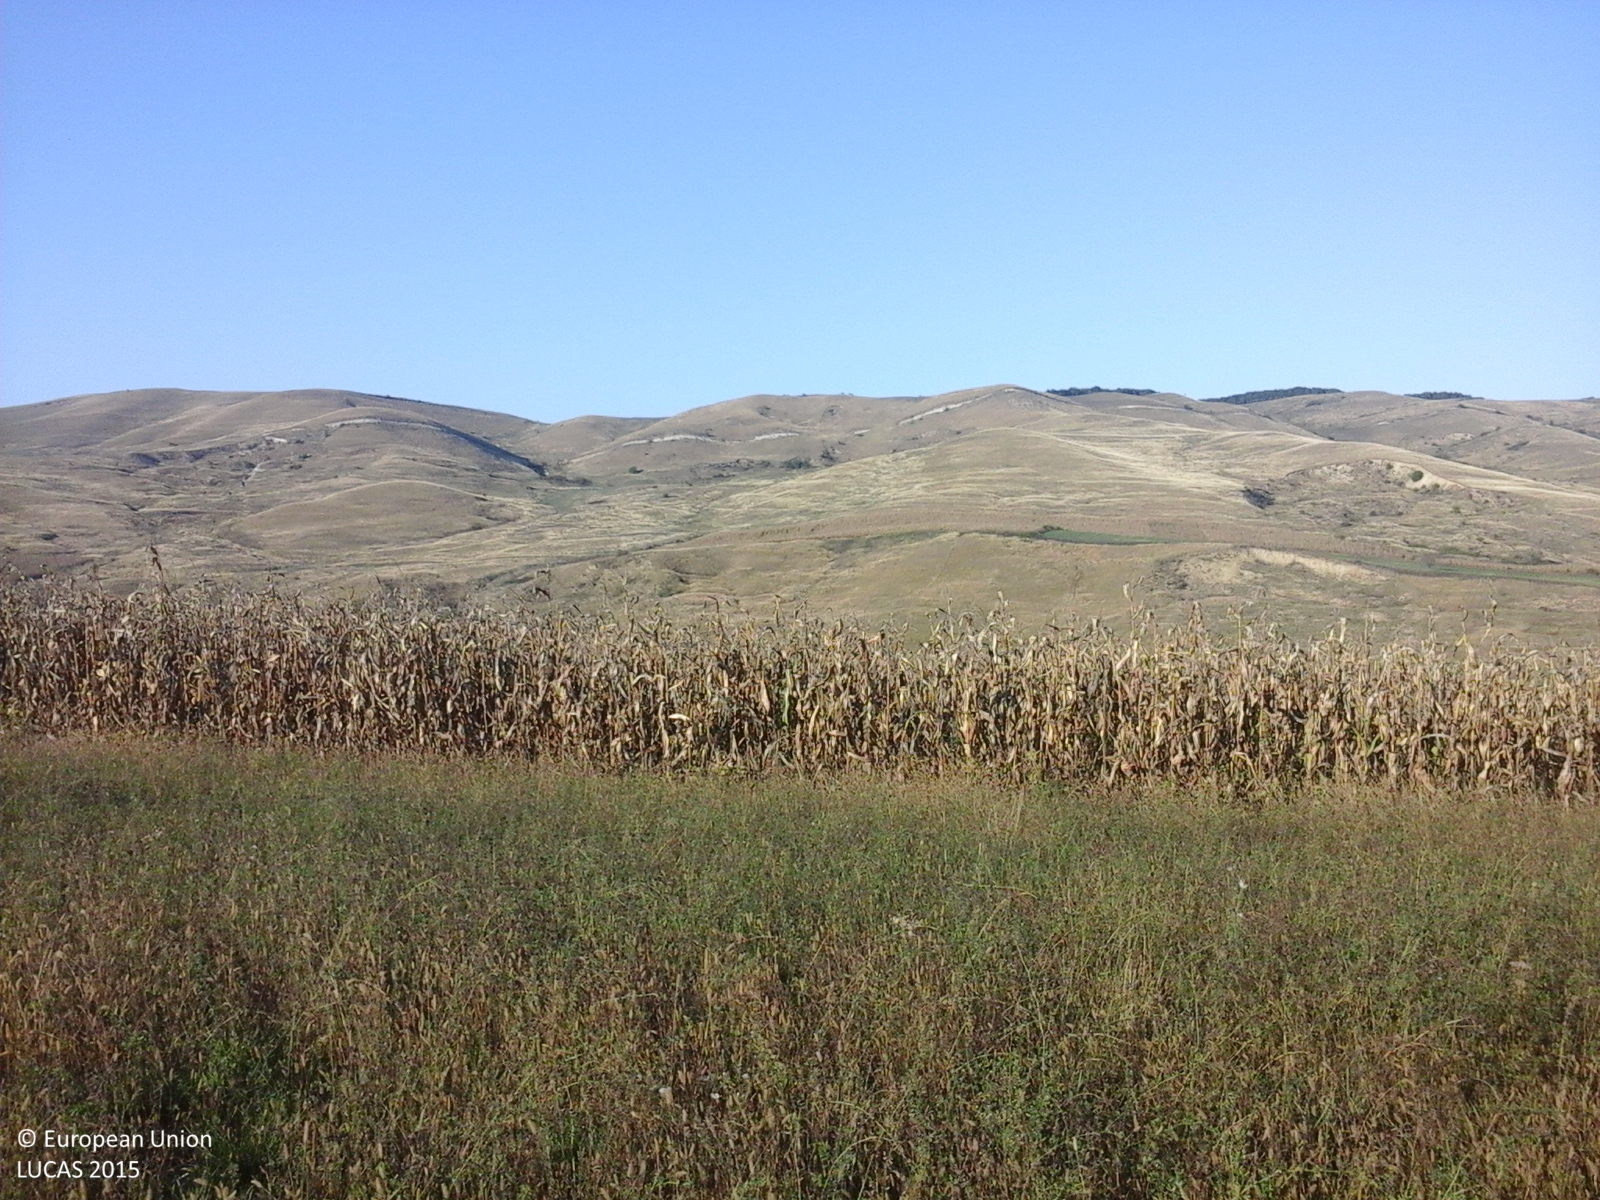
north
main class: Grassland
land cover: Spontaneously vegetated surfaces
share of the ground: > 75 %
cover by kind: herbaceous plants 100 %
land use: Agriculture (excluding fallow land and kitchen gardens)
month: October
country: RO
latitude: 46.2329
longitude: 23.8298
